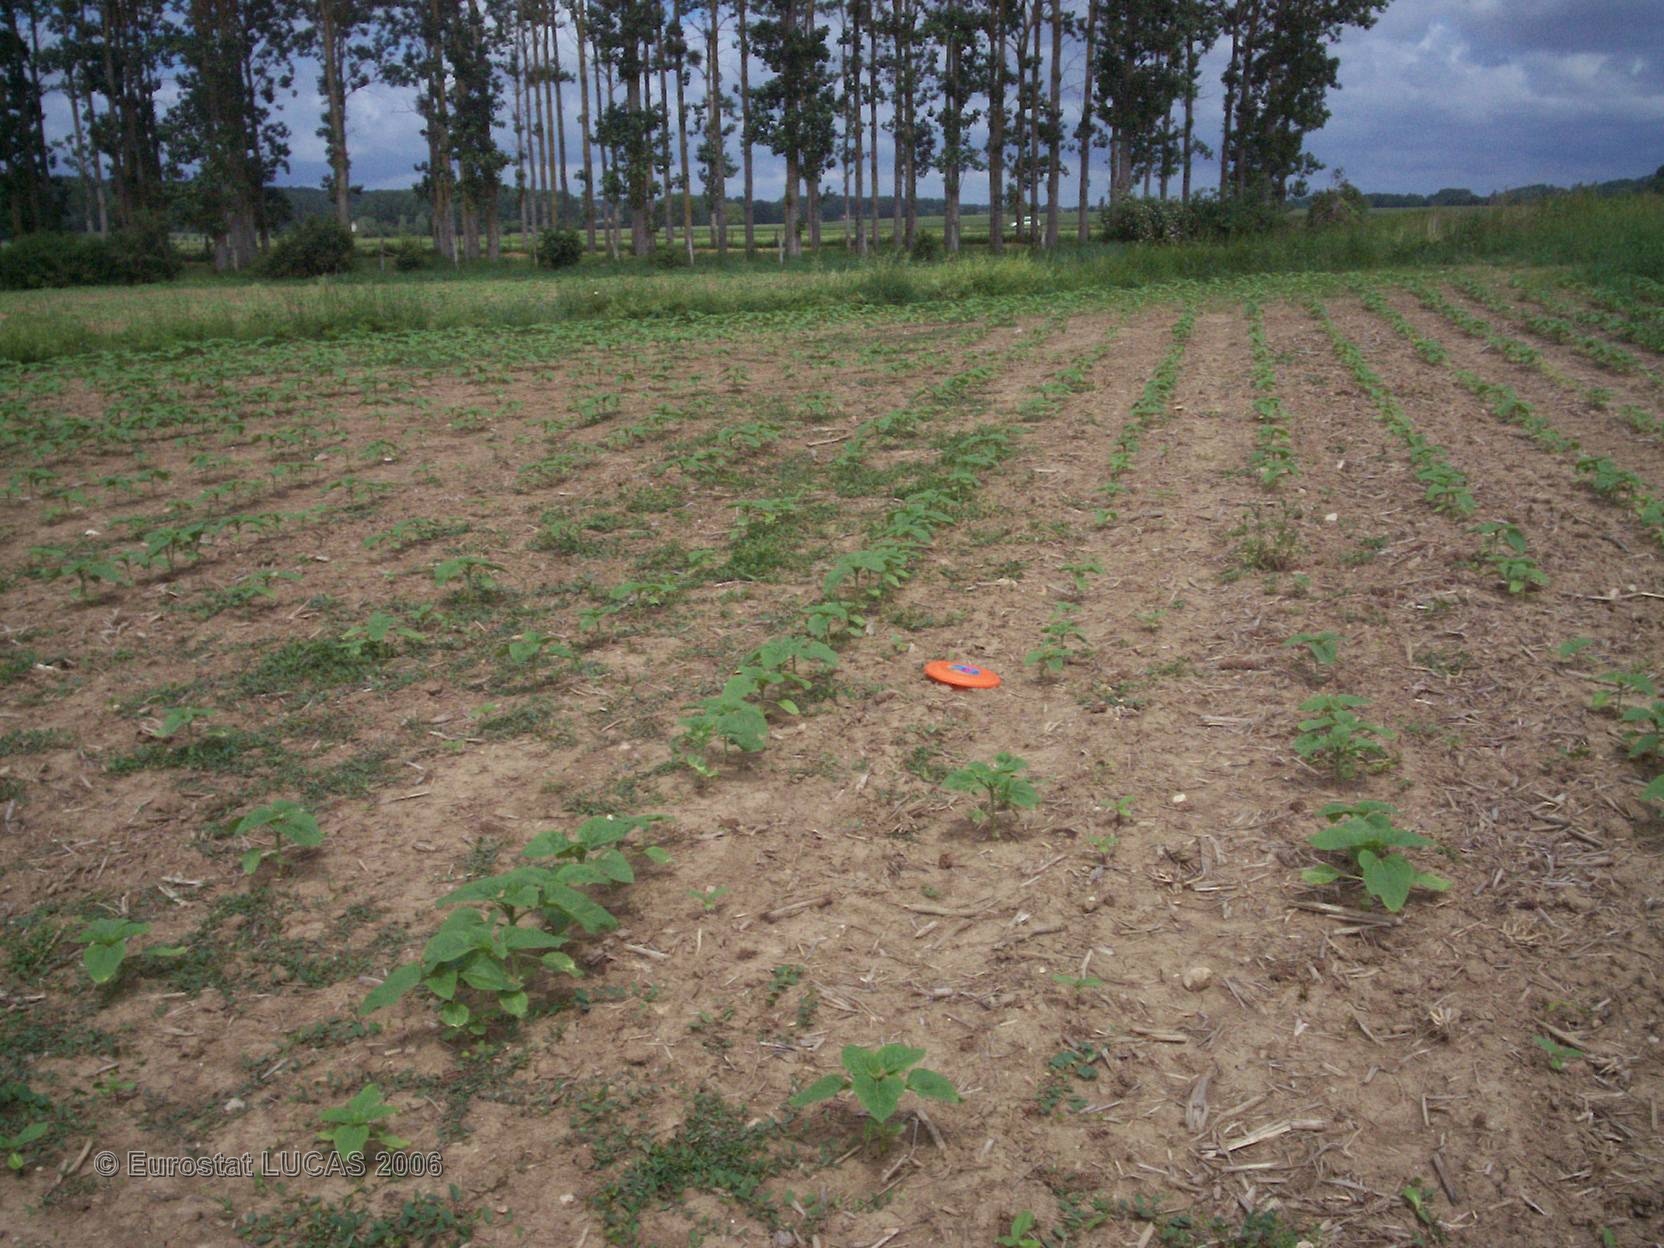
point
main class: Cropland
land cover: Sunflower
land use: Agriculture (excluding fallow land and kitchen gardens)
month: May
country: FR
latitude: 46.6937
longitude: 0.5539
